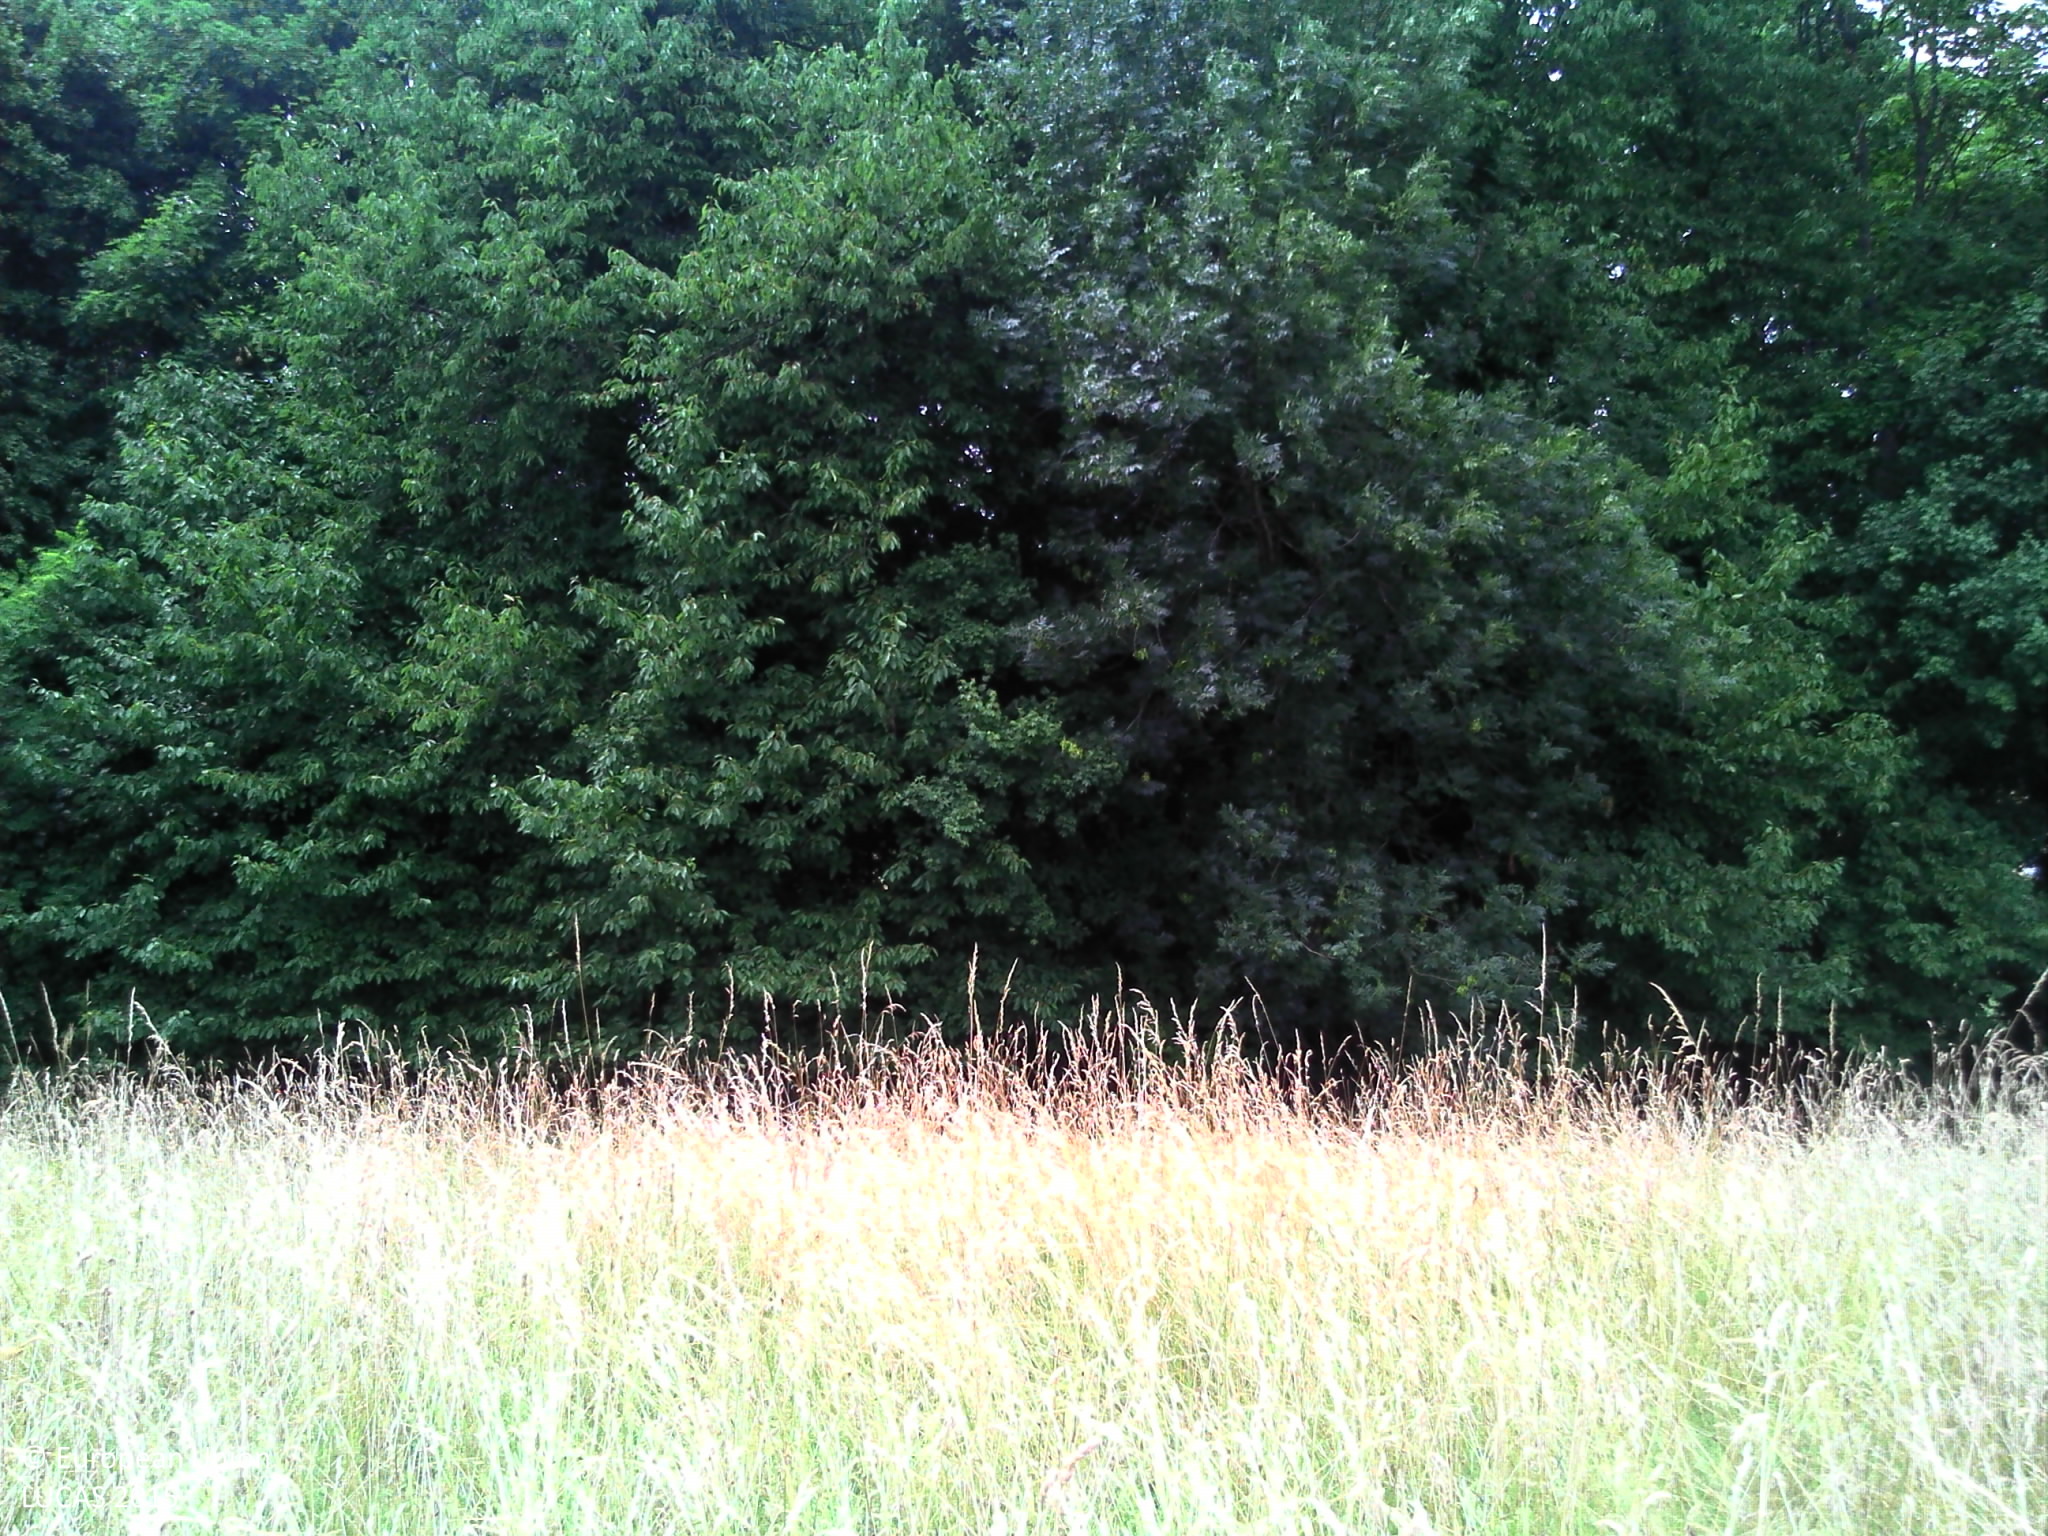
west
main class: Grassland
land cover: Grassland without tree/shrub cover
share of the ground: > 75 %
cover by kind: herbaceous plants 100 %
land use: Agriculture (excluding fallow land and kitchen gardens)
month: July
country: FR
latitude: 45.6588
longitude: 3.1084
